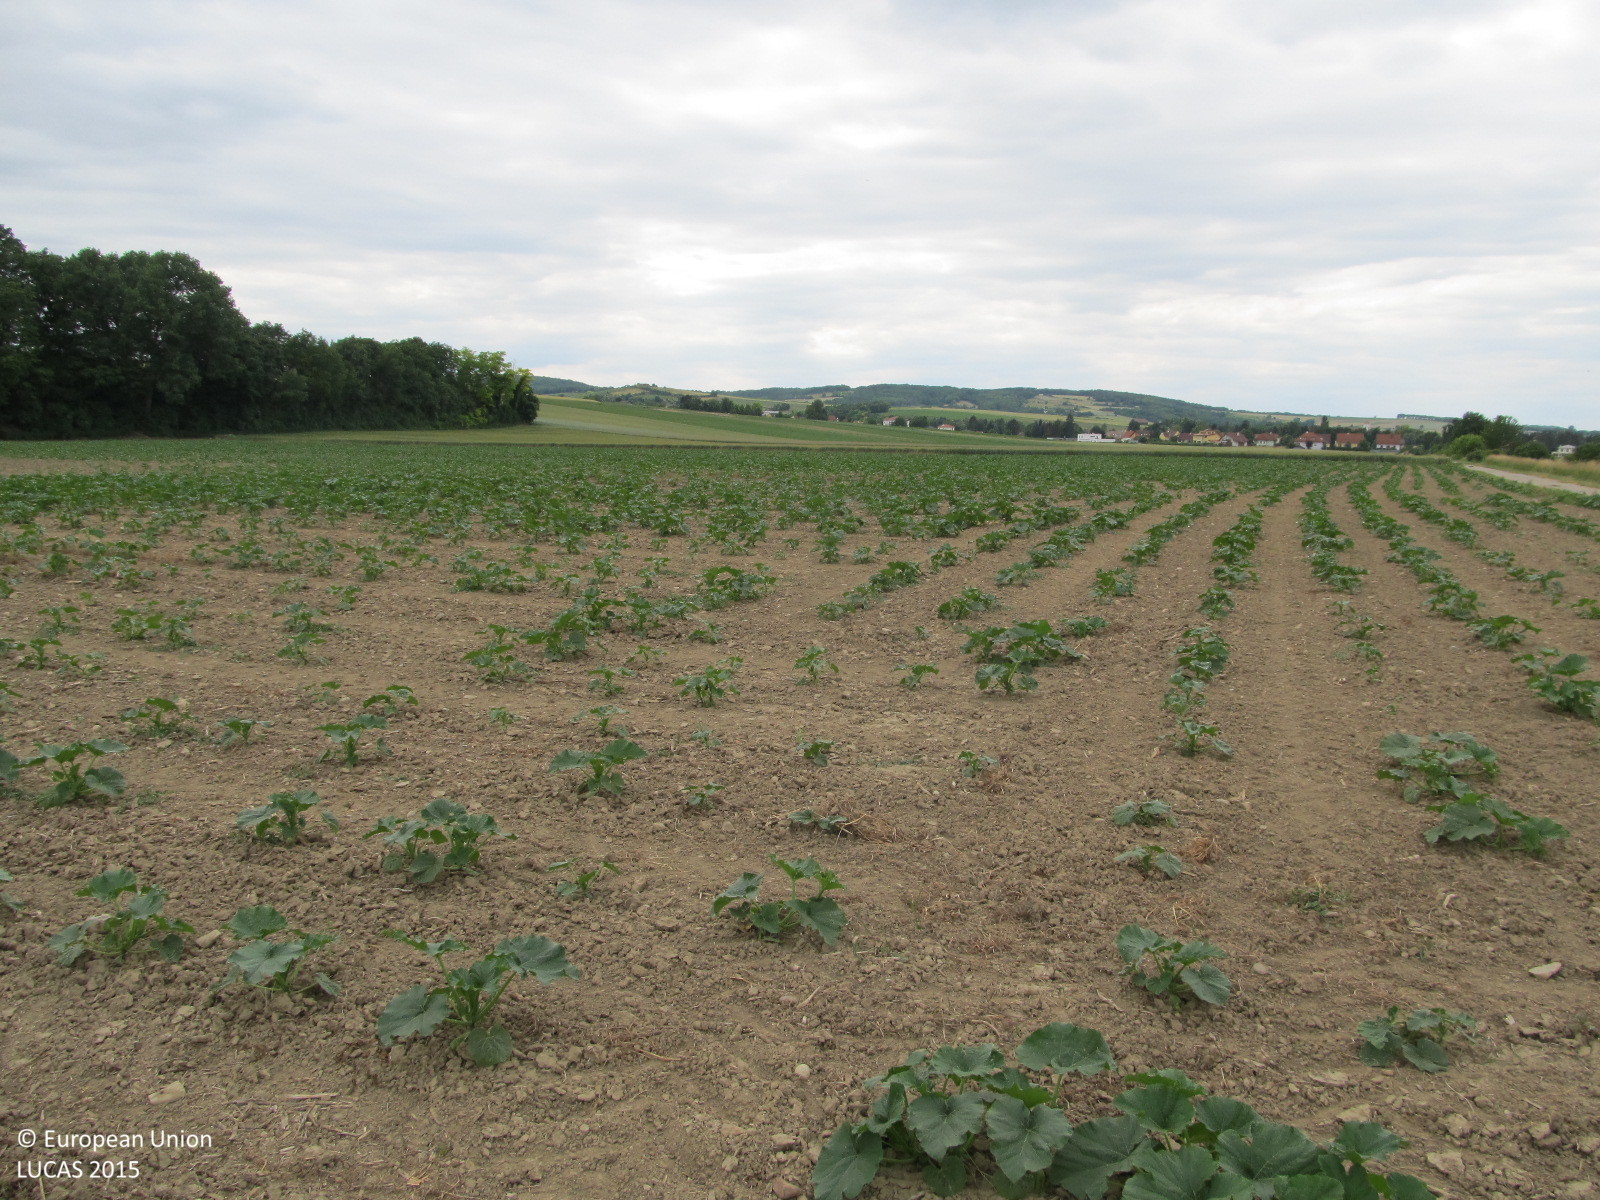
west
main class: Cropland
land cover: Other fibre and oleaginous crops
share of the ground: < 10 %
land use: Agriculture (excluding fallow land and kitchen gardens)
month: June
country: AT
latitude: 48.5067
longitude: 16.0819
